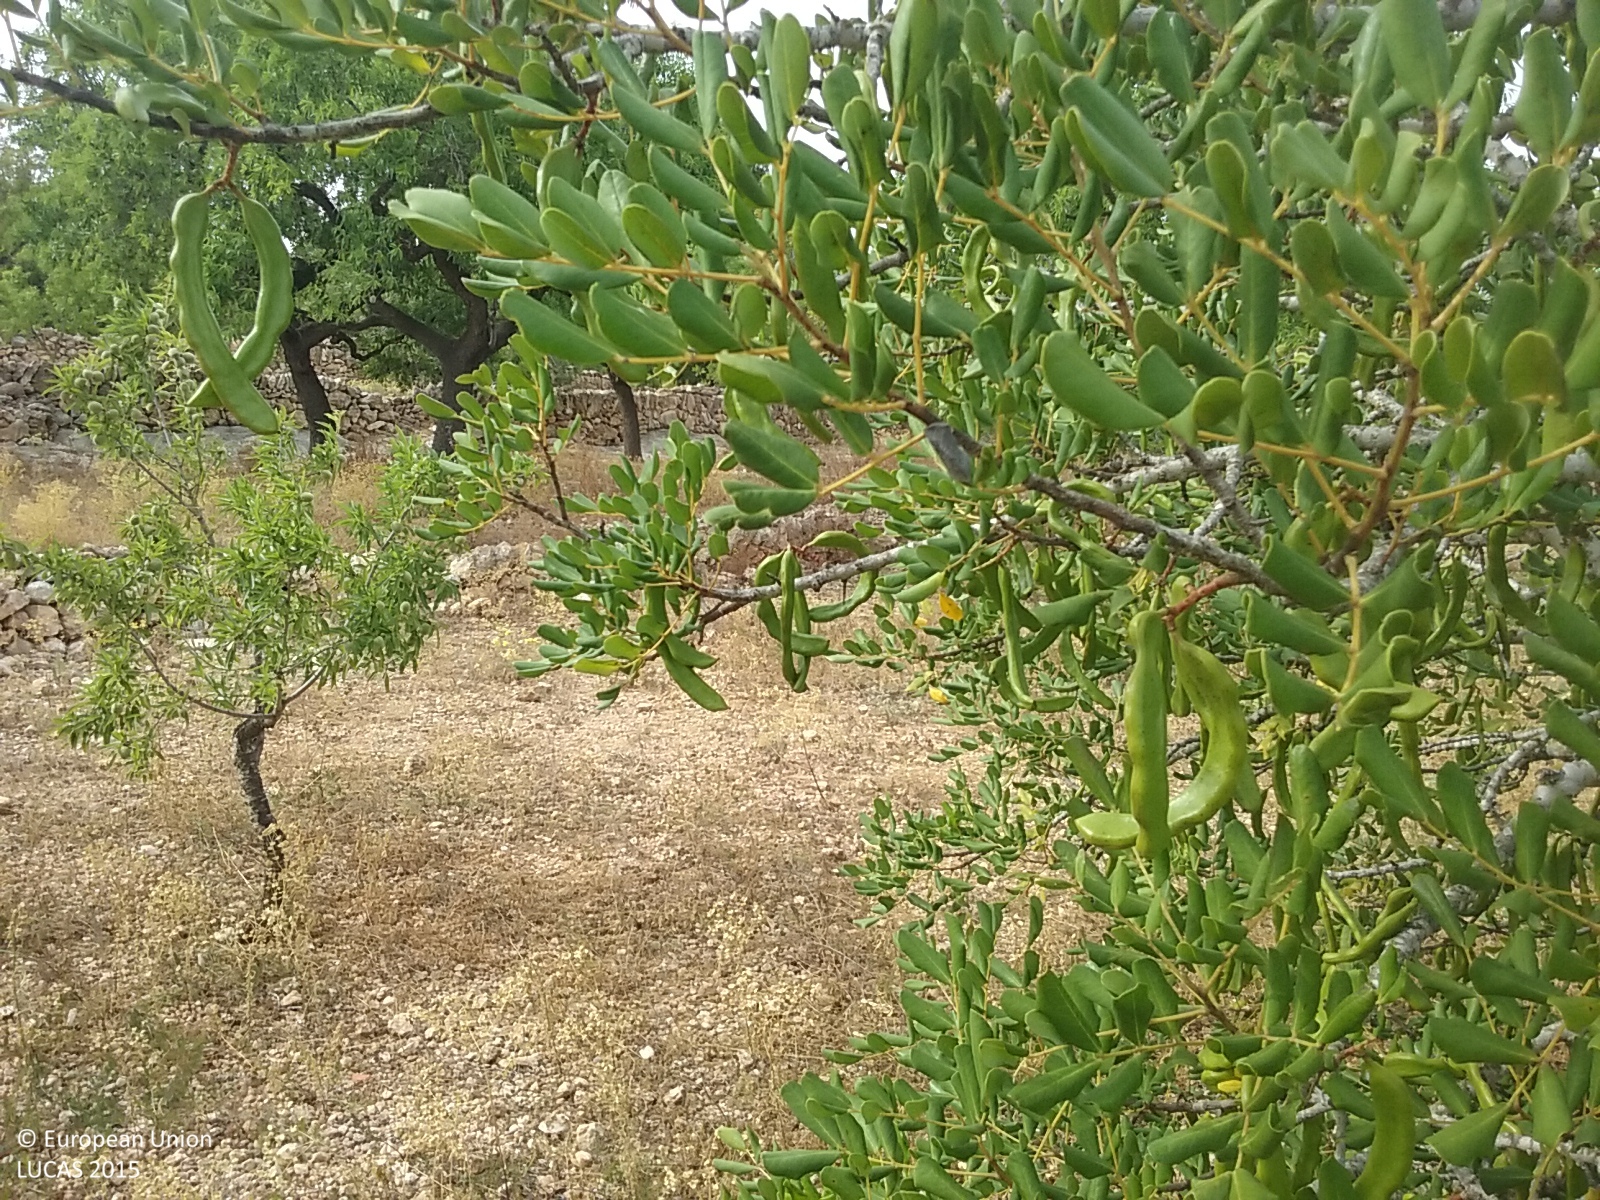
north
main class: Cropland
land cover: Nuts trees
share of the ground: 25 - 50 %
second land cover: Spontaneously vegetated surfaces
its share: 50 - 75 %
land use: Agriculture (excluding fallow land and kitchen gardens)
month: May
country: ES
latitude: 40.8288
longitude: 0.5431
